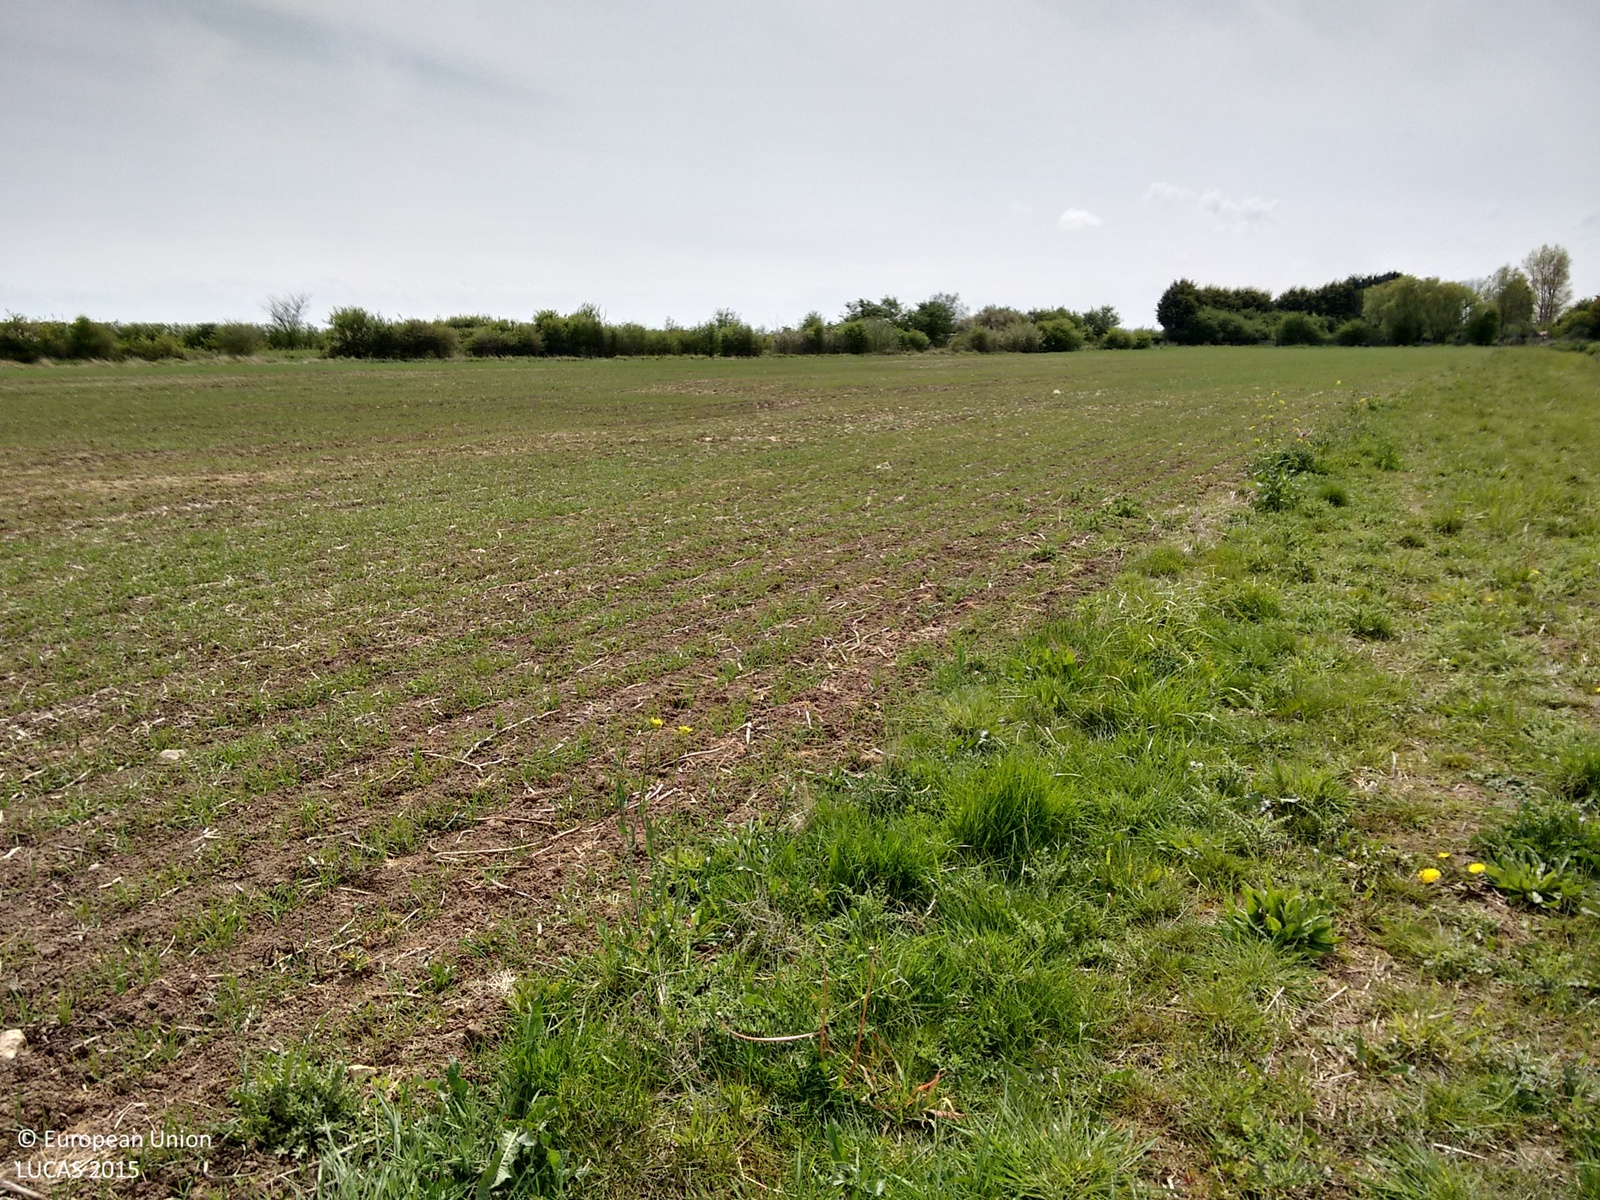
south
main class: Grassland
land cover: Grassland without tree/shrub cover
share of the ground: > 75 %
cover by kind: herbaceous plants 100 %
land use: Agriculture (excluding fallow land and kitchen gardens)
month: May
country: GB
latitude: 53.3446
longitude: 0.1614
